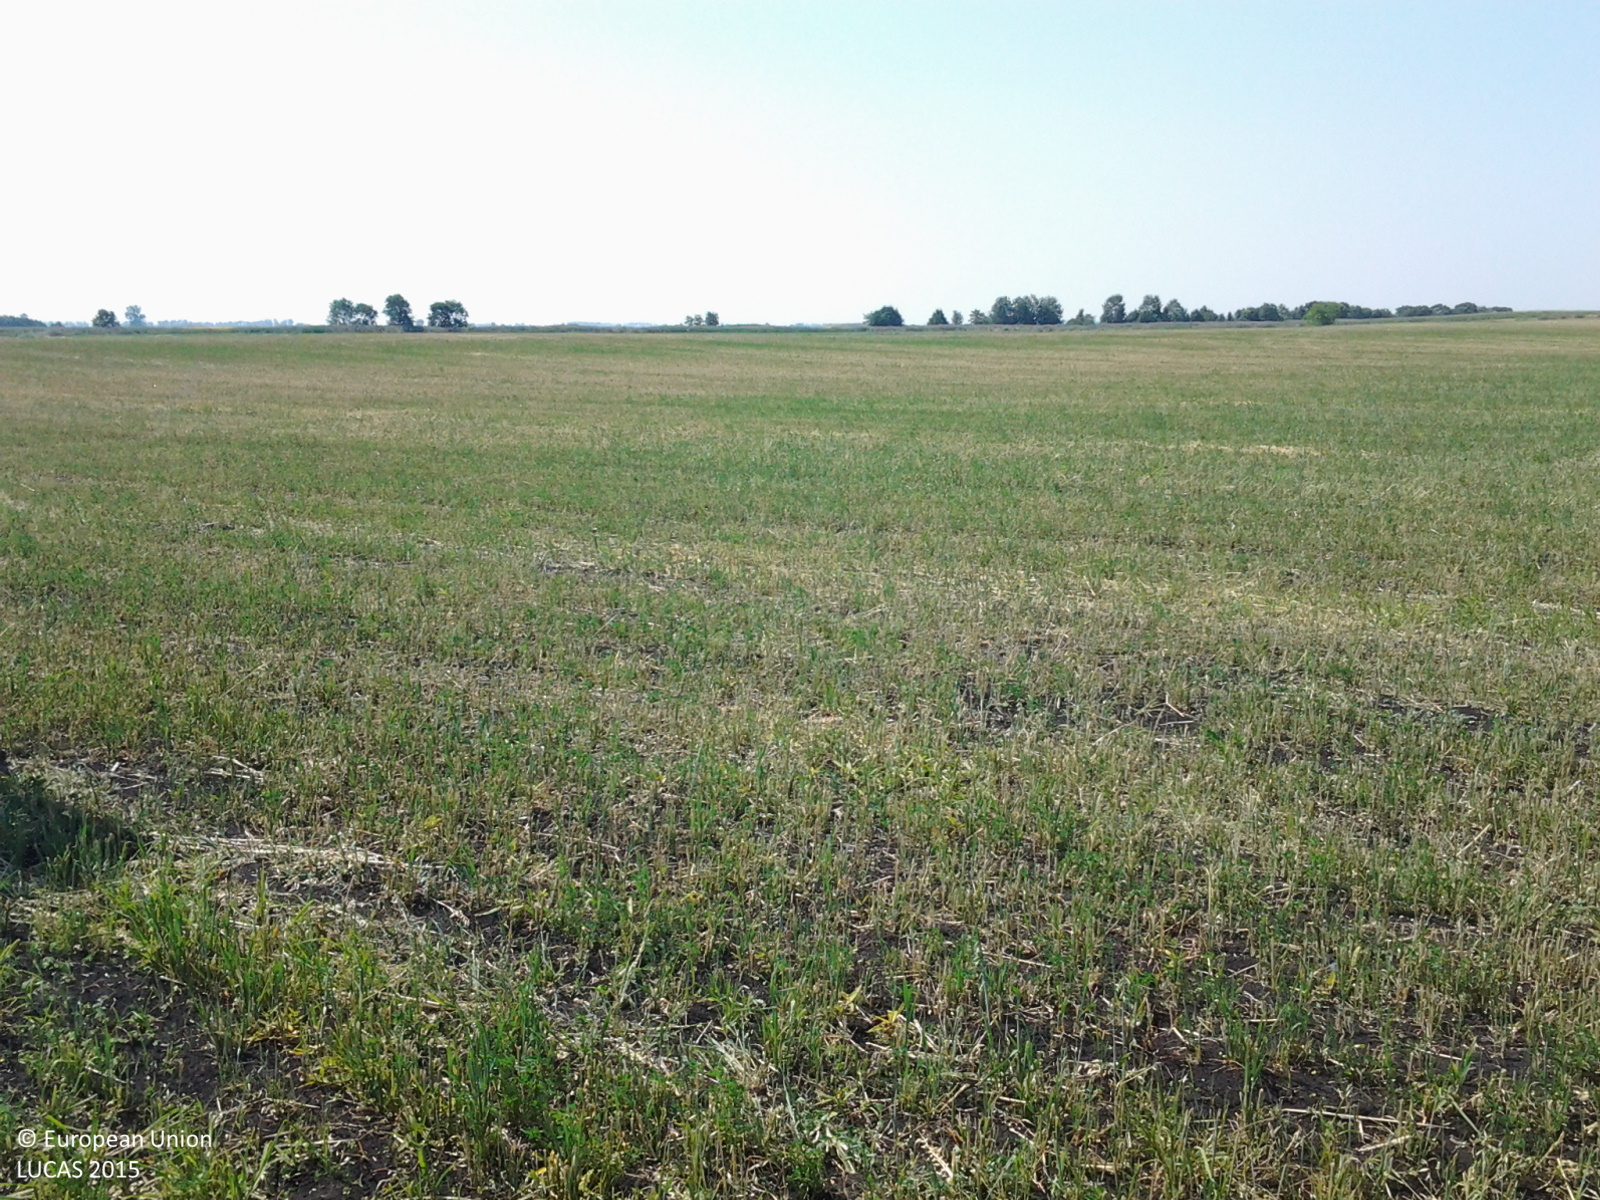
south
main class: Cropland
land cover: Oats
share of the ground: < 10 %
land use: Agriculture (excluding fallow land and kitchen gardens)
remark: Harvested field
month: July
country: HU
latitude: 47.4514
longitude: 20.2809
